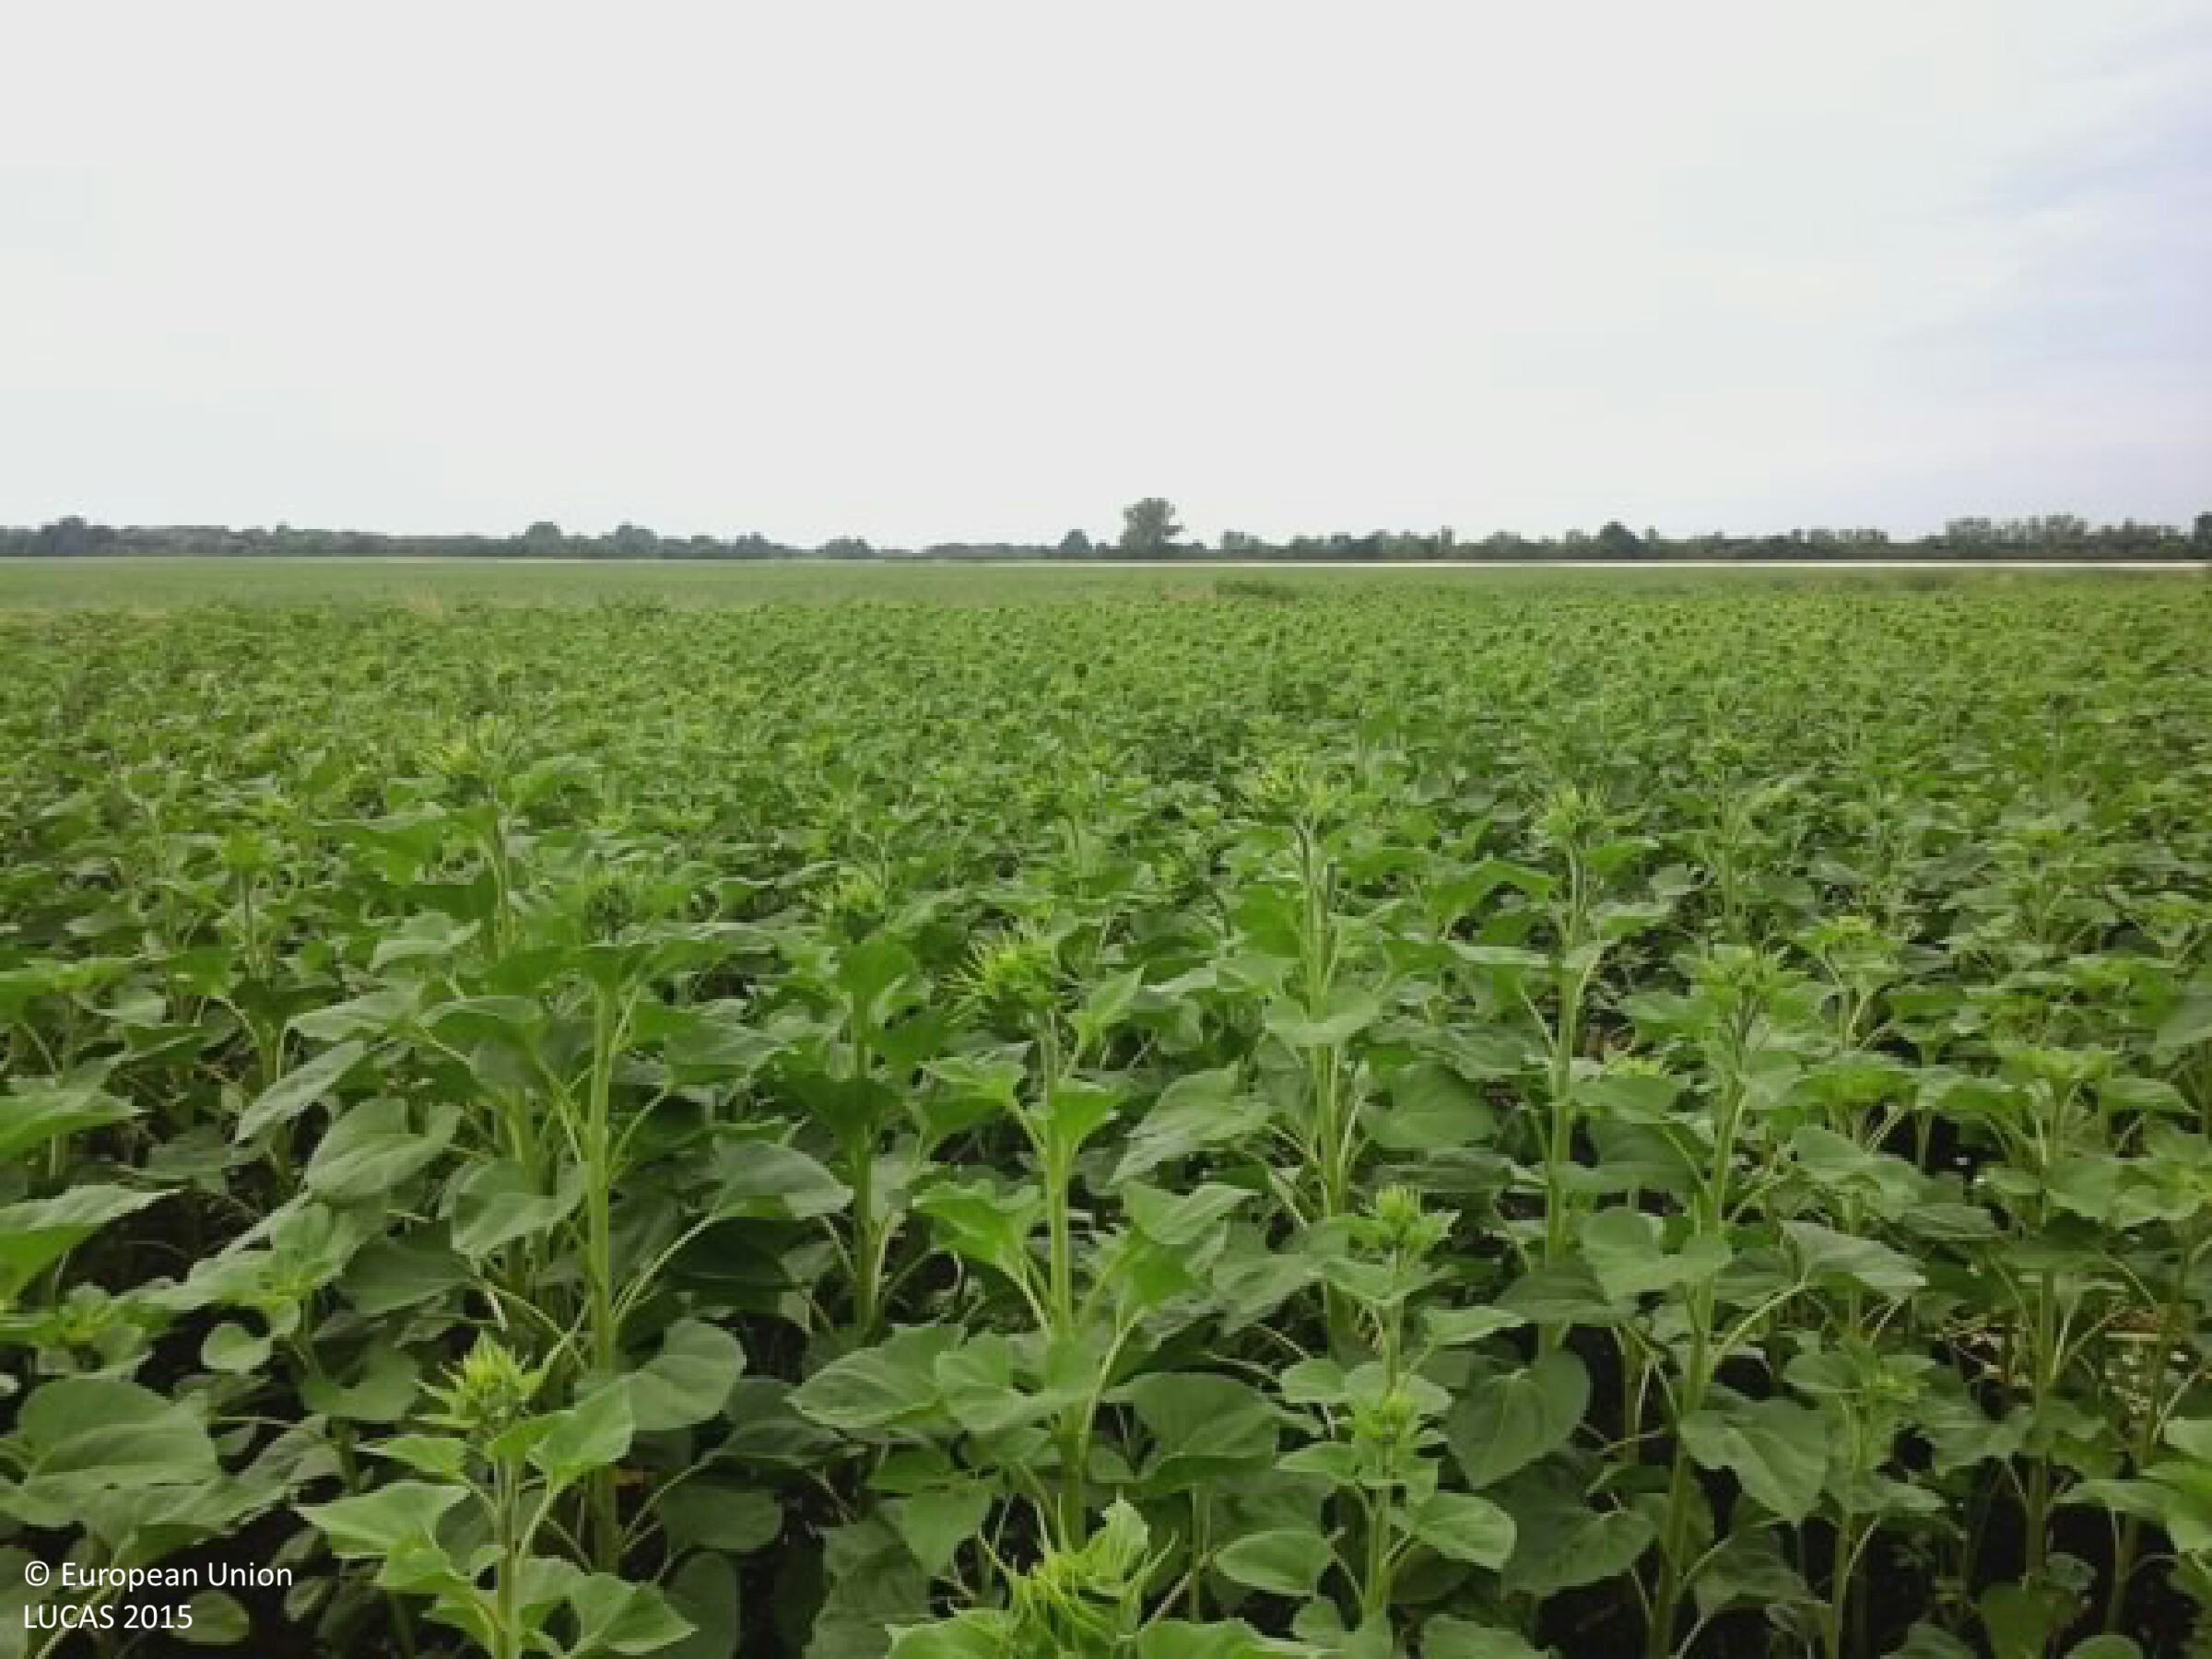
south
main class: Cropland
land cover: Sunflower
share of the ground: > 75 %
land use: Agriculture (excluding fallow land and kitchen gardens)
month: June
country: HU
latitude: 46.5227
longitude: 20.1256
